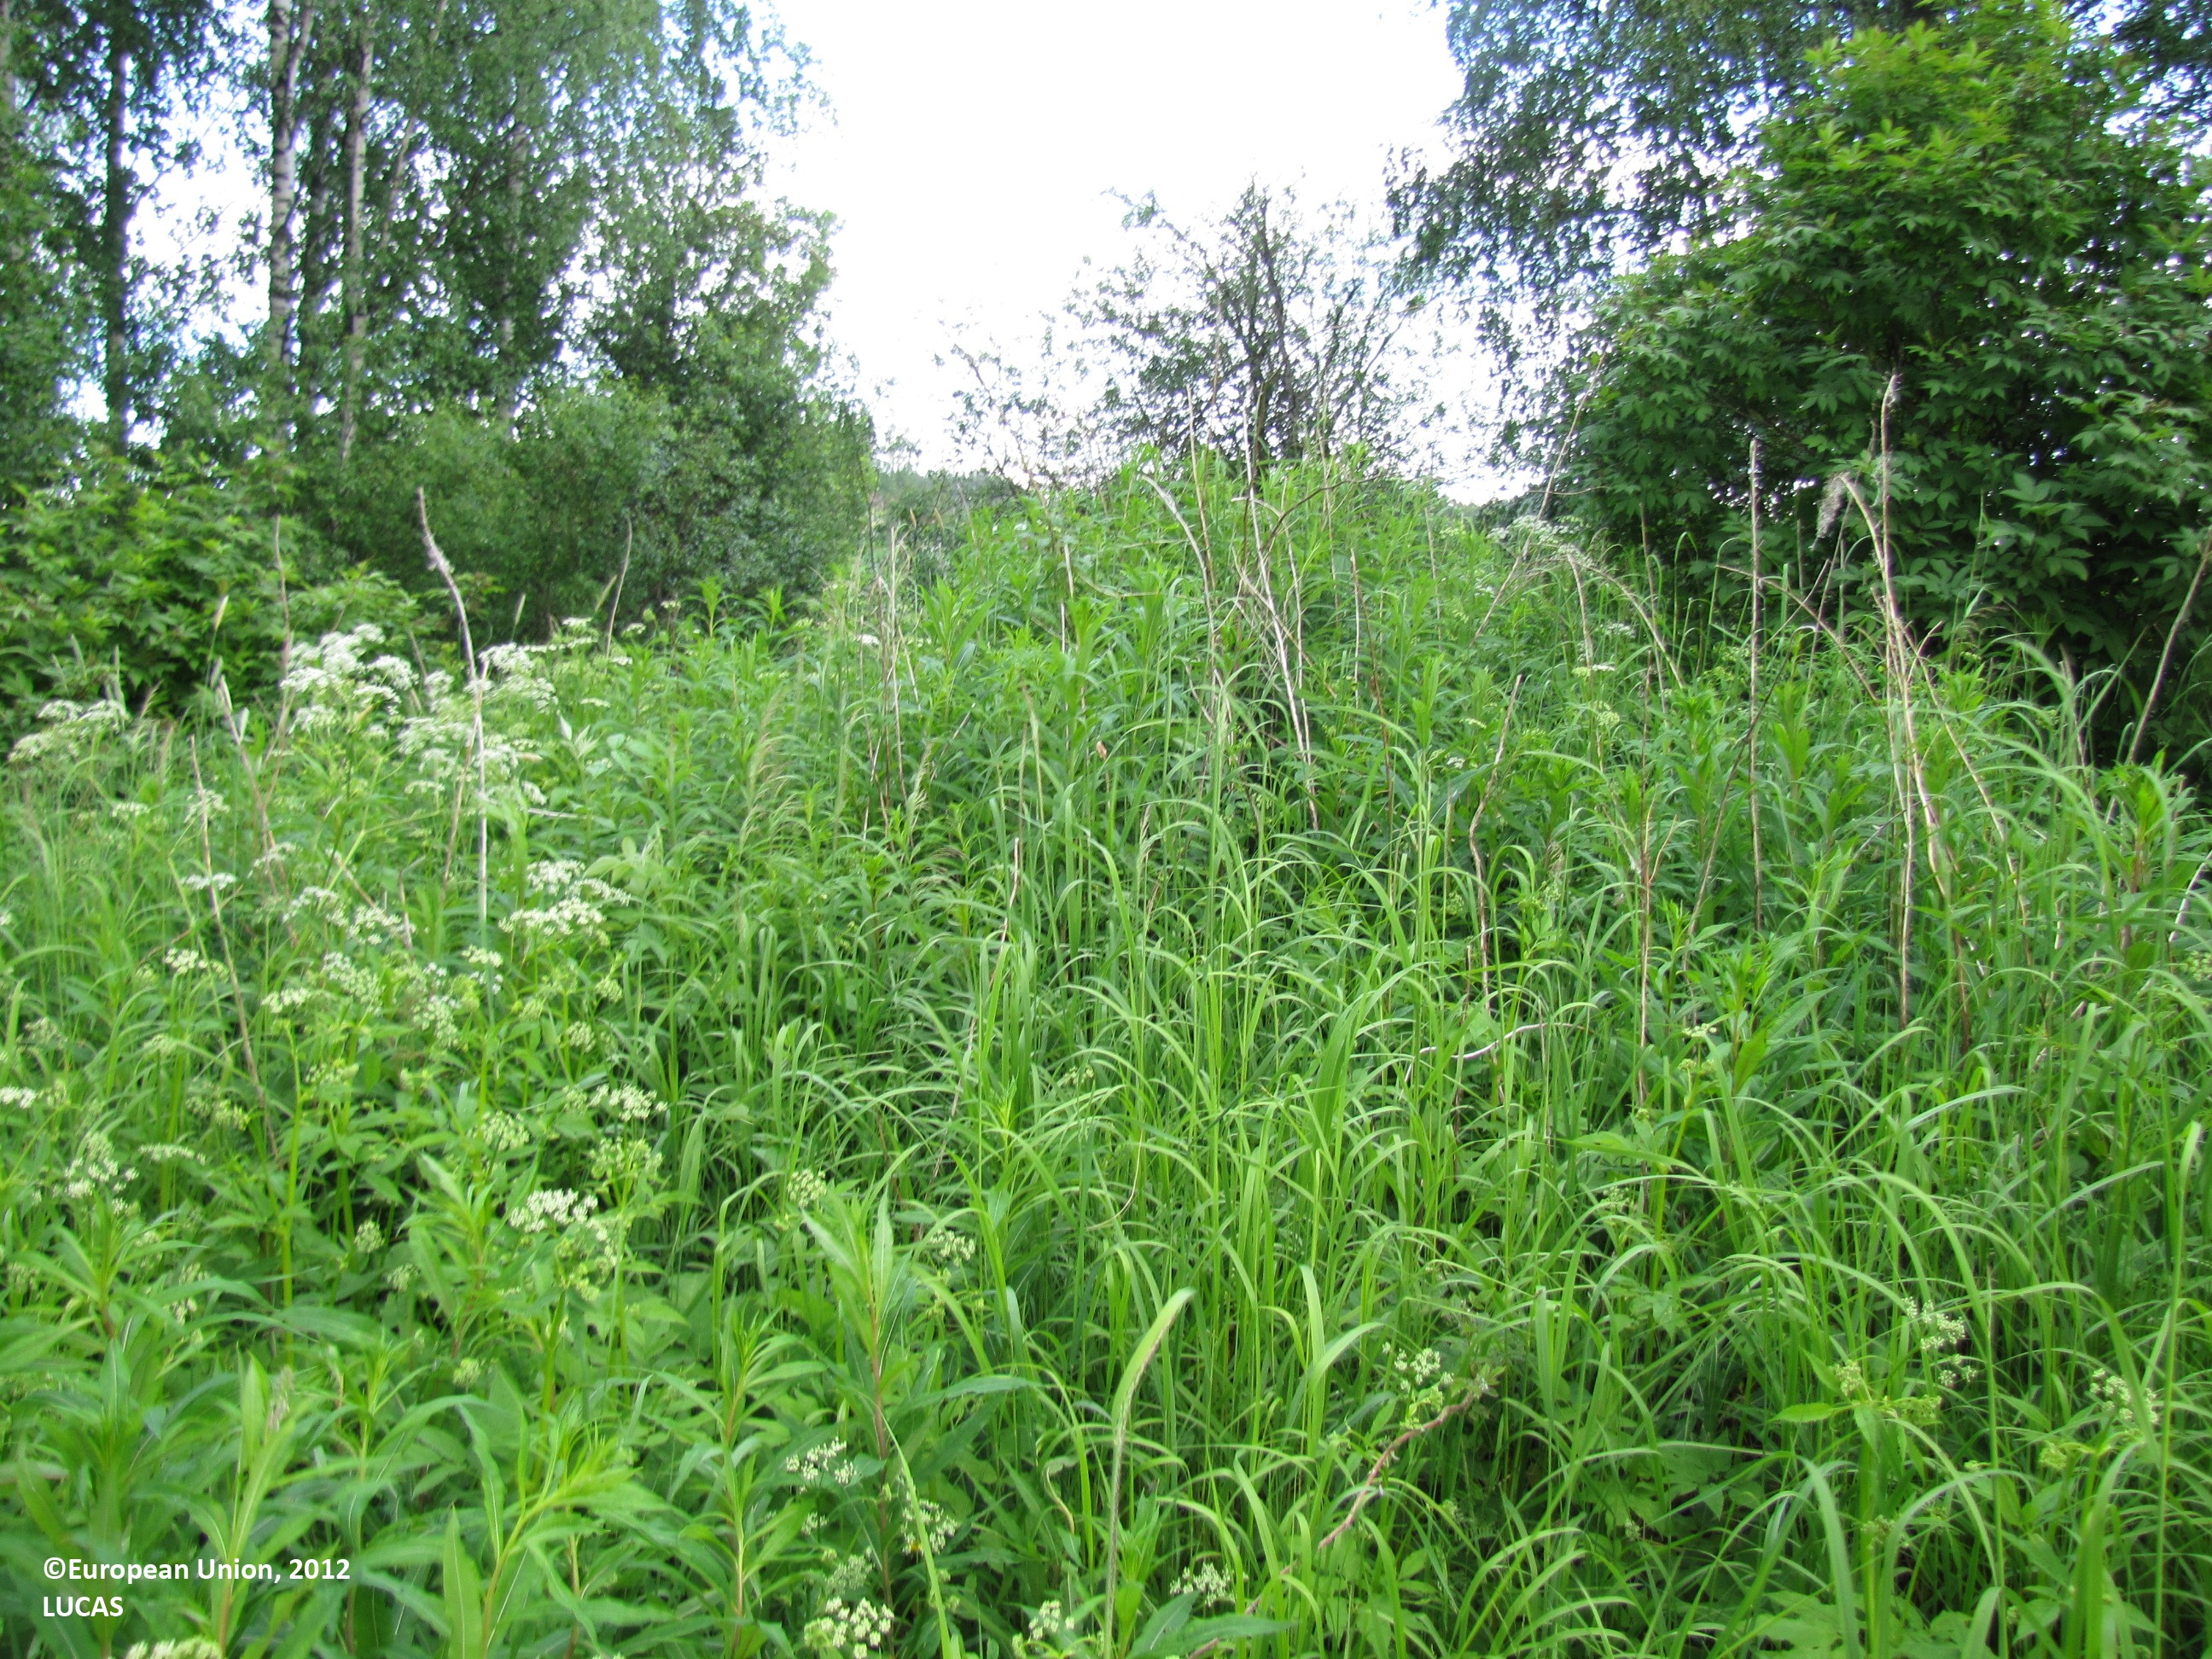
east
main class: Cropland
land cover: Oats
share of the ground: 50 - 75 %
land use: Agriculture (excluding fallow land and kitchen gardens)
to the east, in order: Oats; Broadleaved woodland; Ditches and canals; Broadleaved woodland; Ditches and canals; Grass margins; Barley
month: June
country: FI
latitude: 61.6939
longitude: 24.4056
